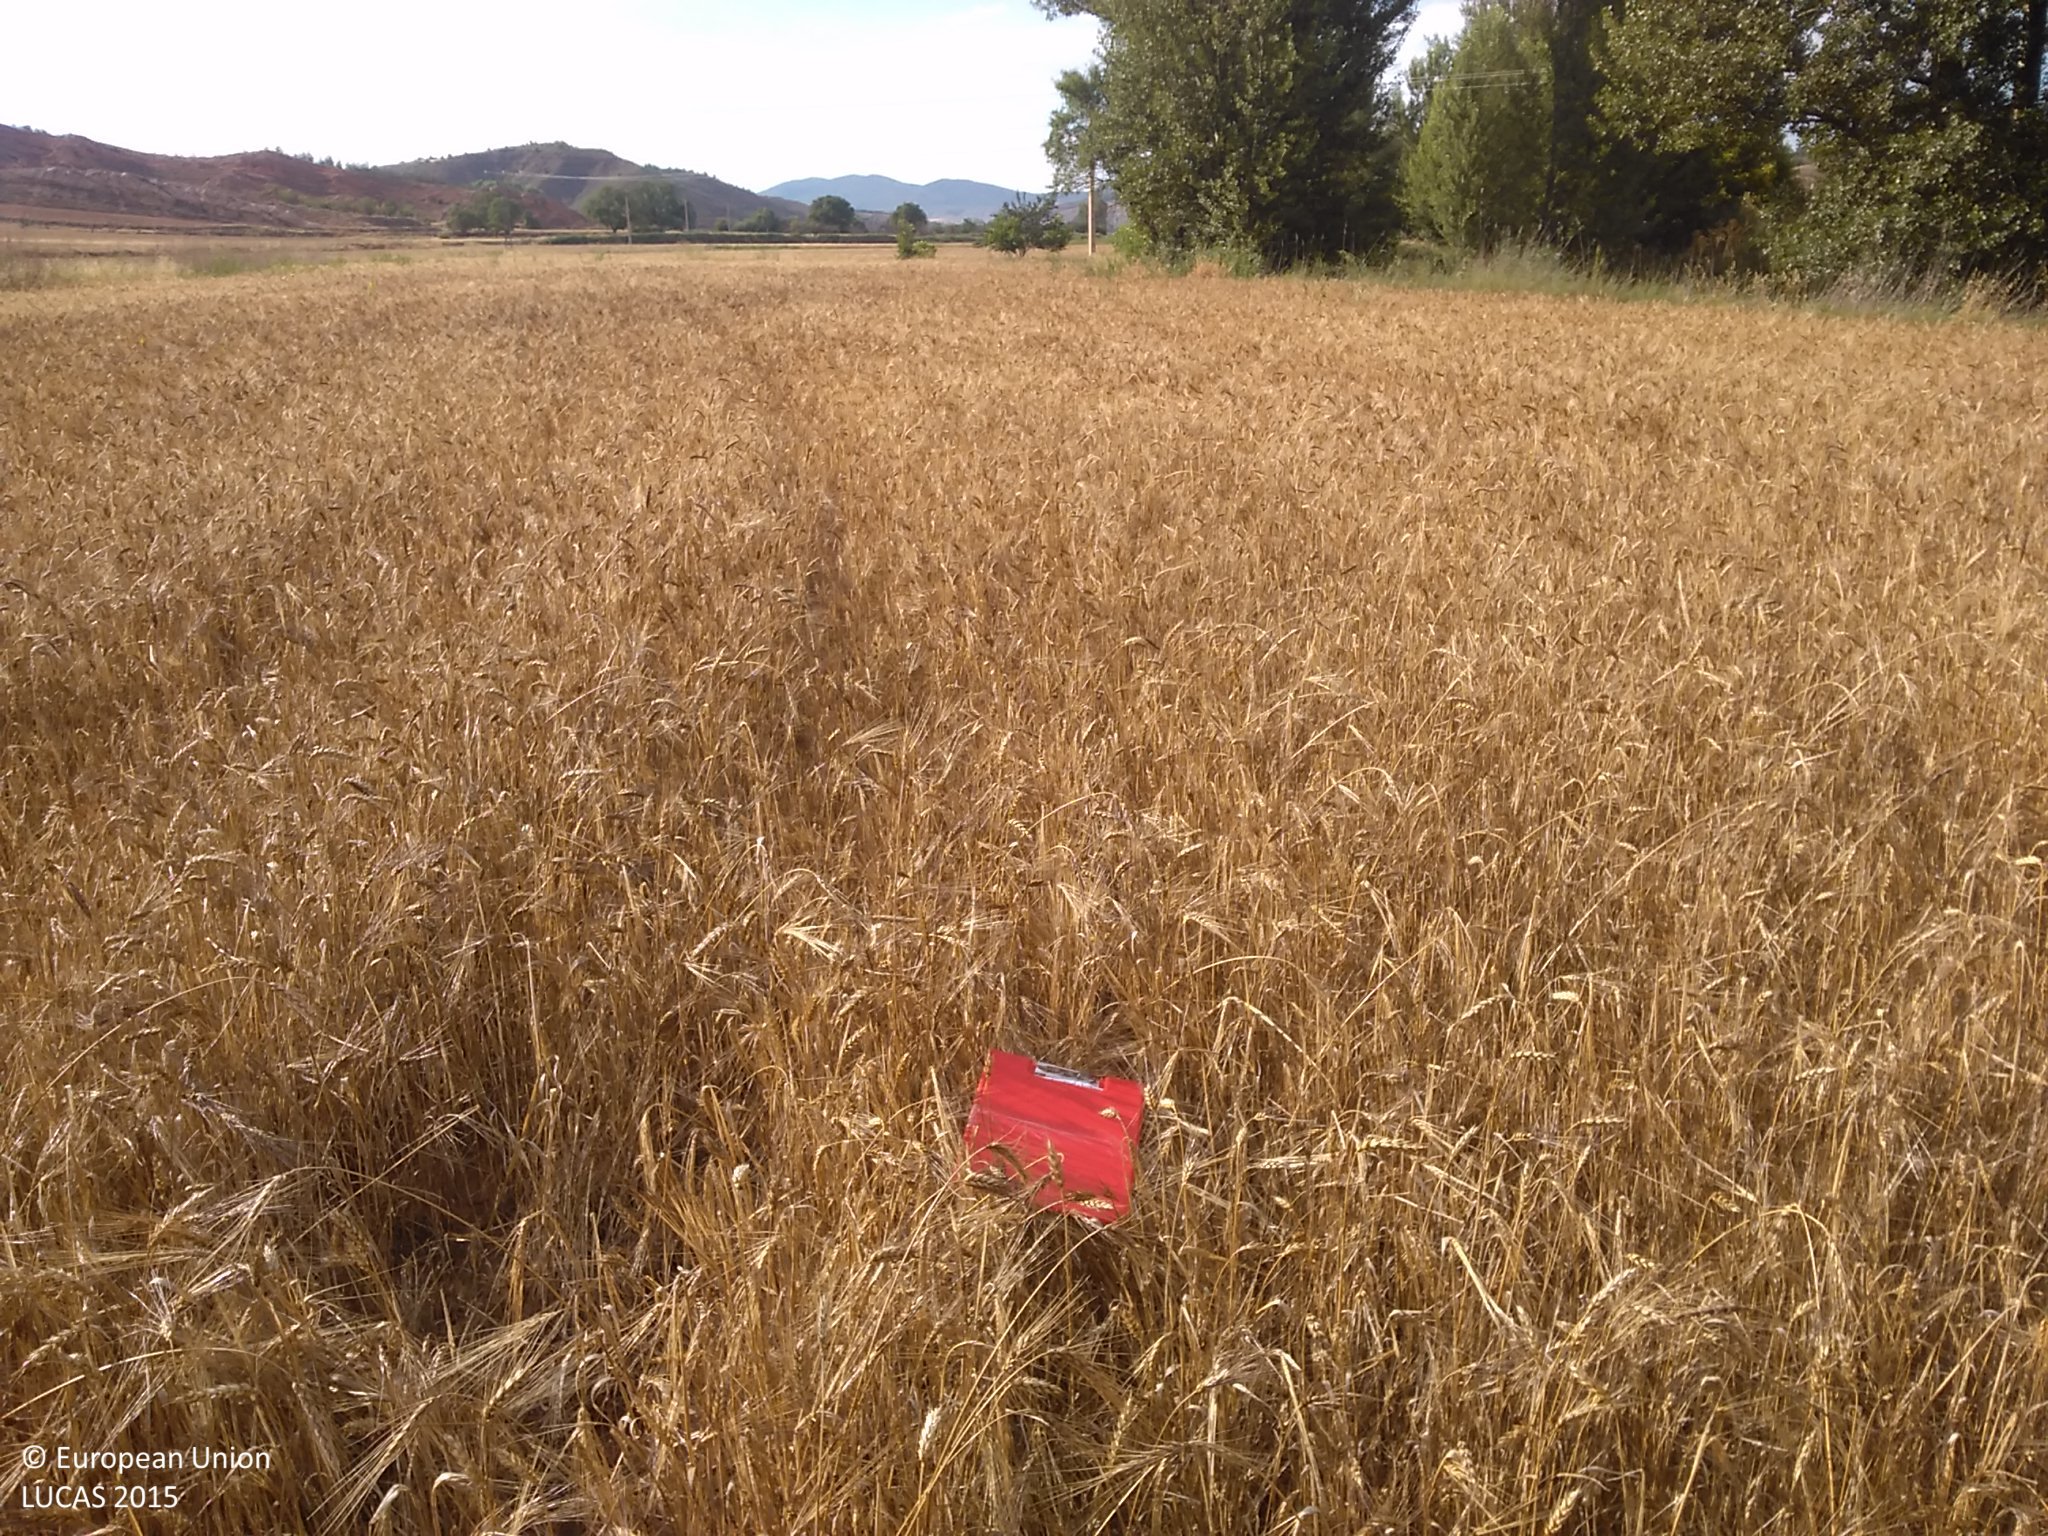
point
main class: Cropland
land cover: Common wheat
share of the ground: > 75 %
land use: Agriculture (excluding fallow land and kitchen gardens)
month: July
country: ES
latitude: 41.4083
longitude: -2.0039
